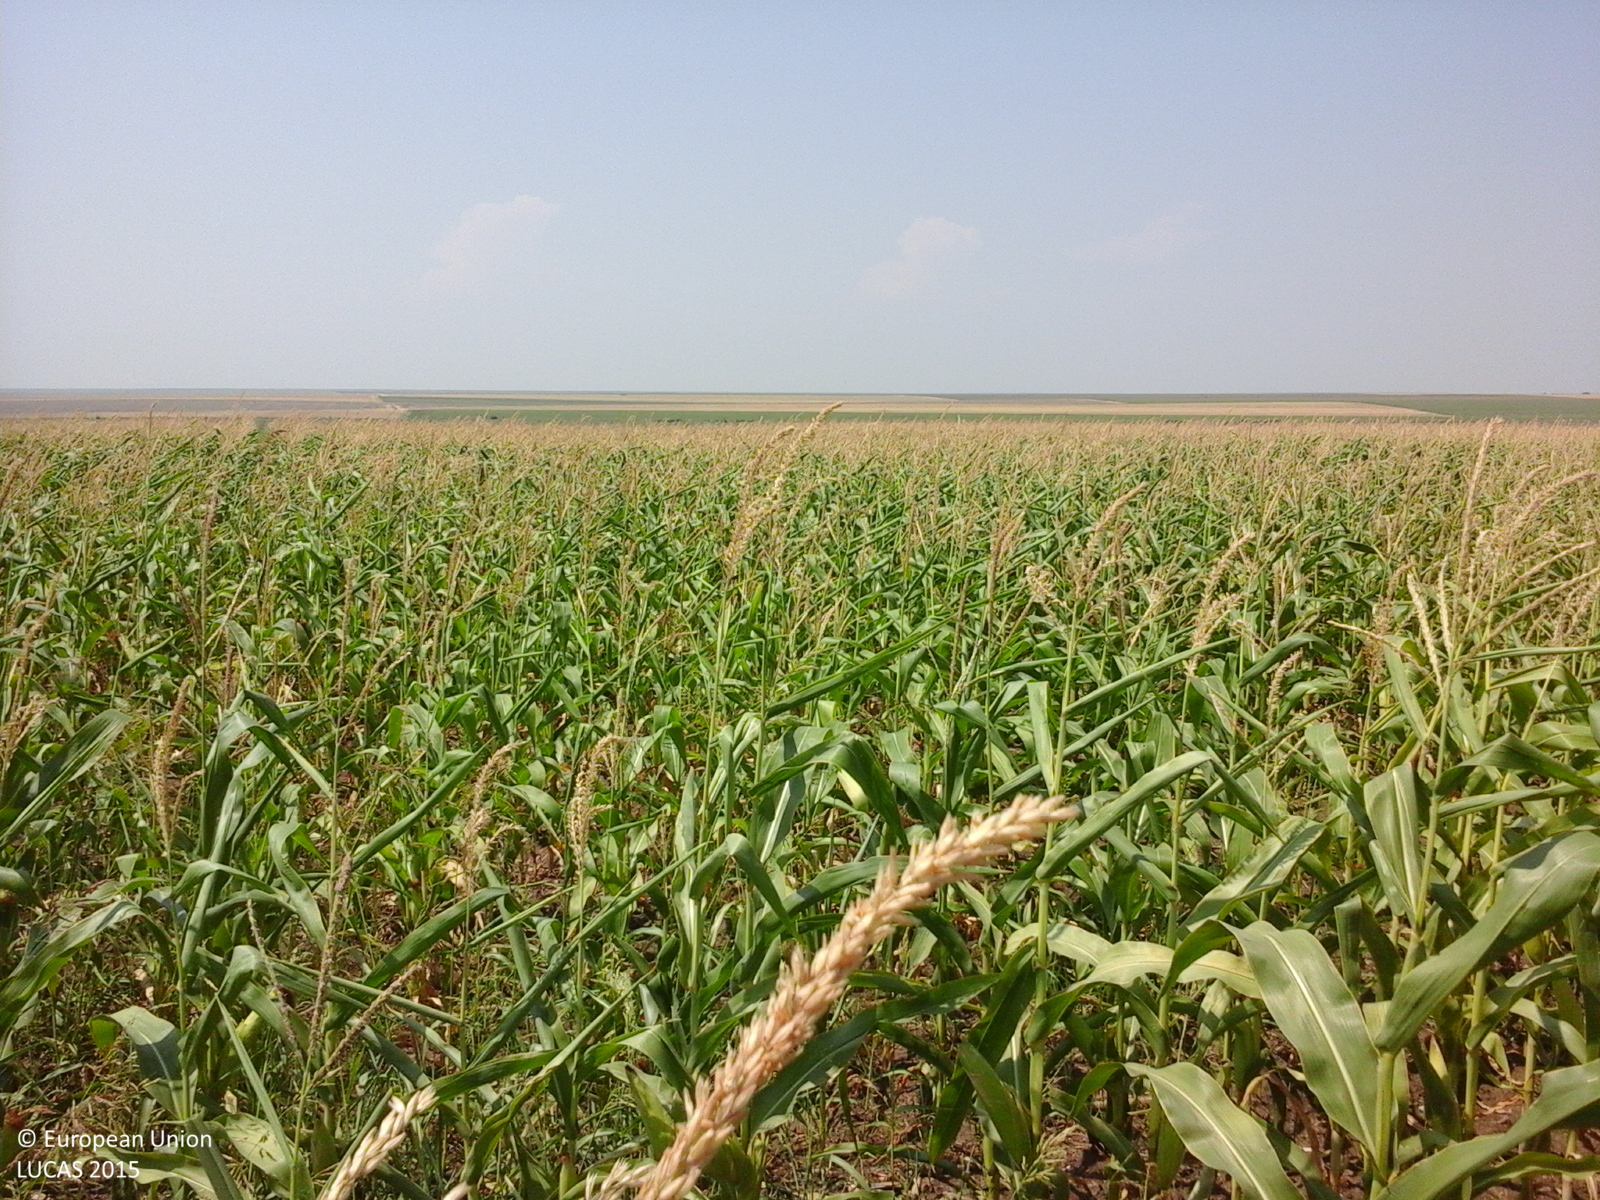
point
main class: Cropland
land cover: Maize
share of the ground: > 75 %
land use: Agriculture (excluding fallow land and kitchen gardens)
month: July
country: RO
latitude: 45.6782
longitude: 27.8705
